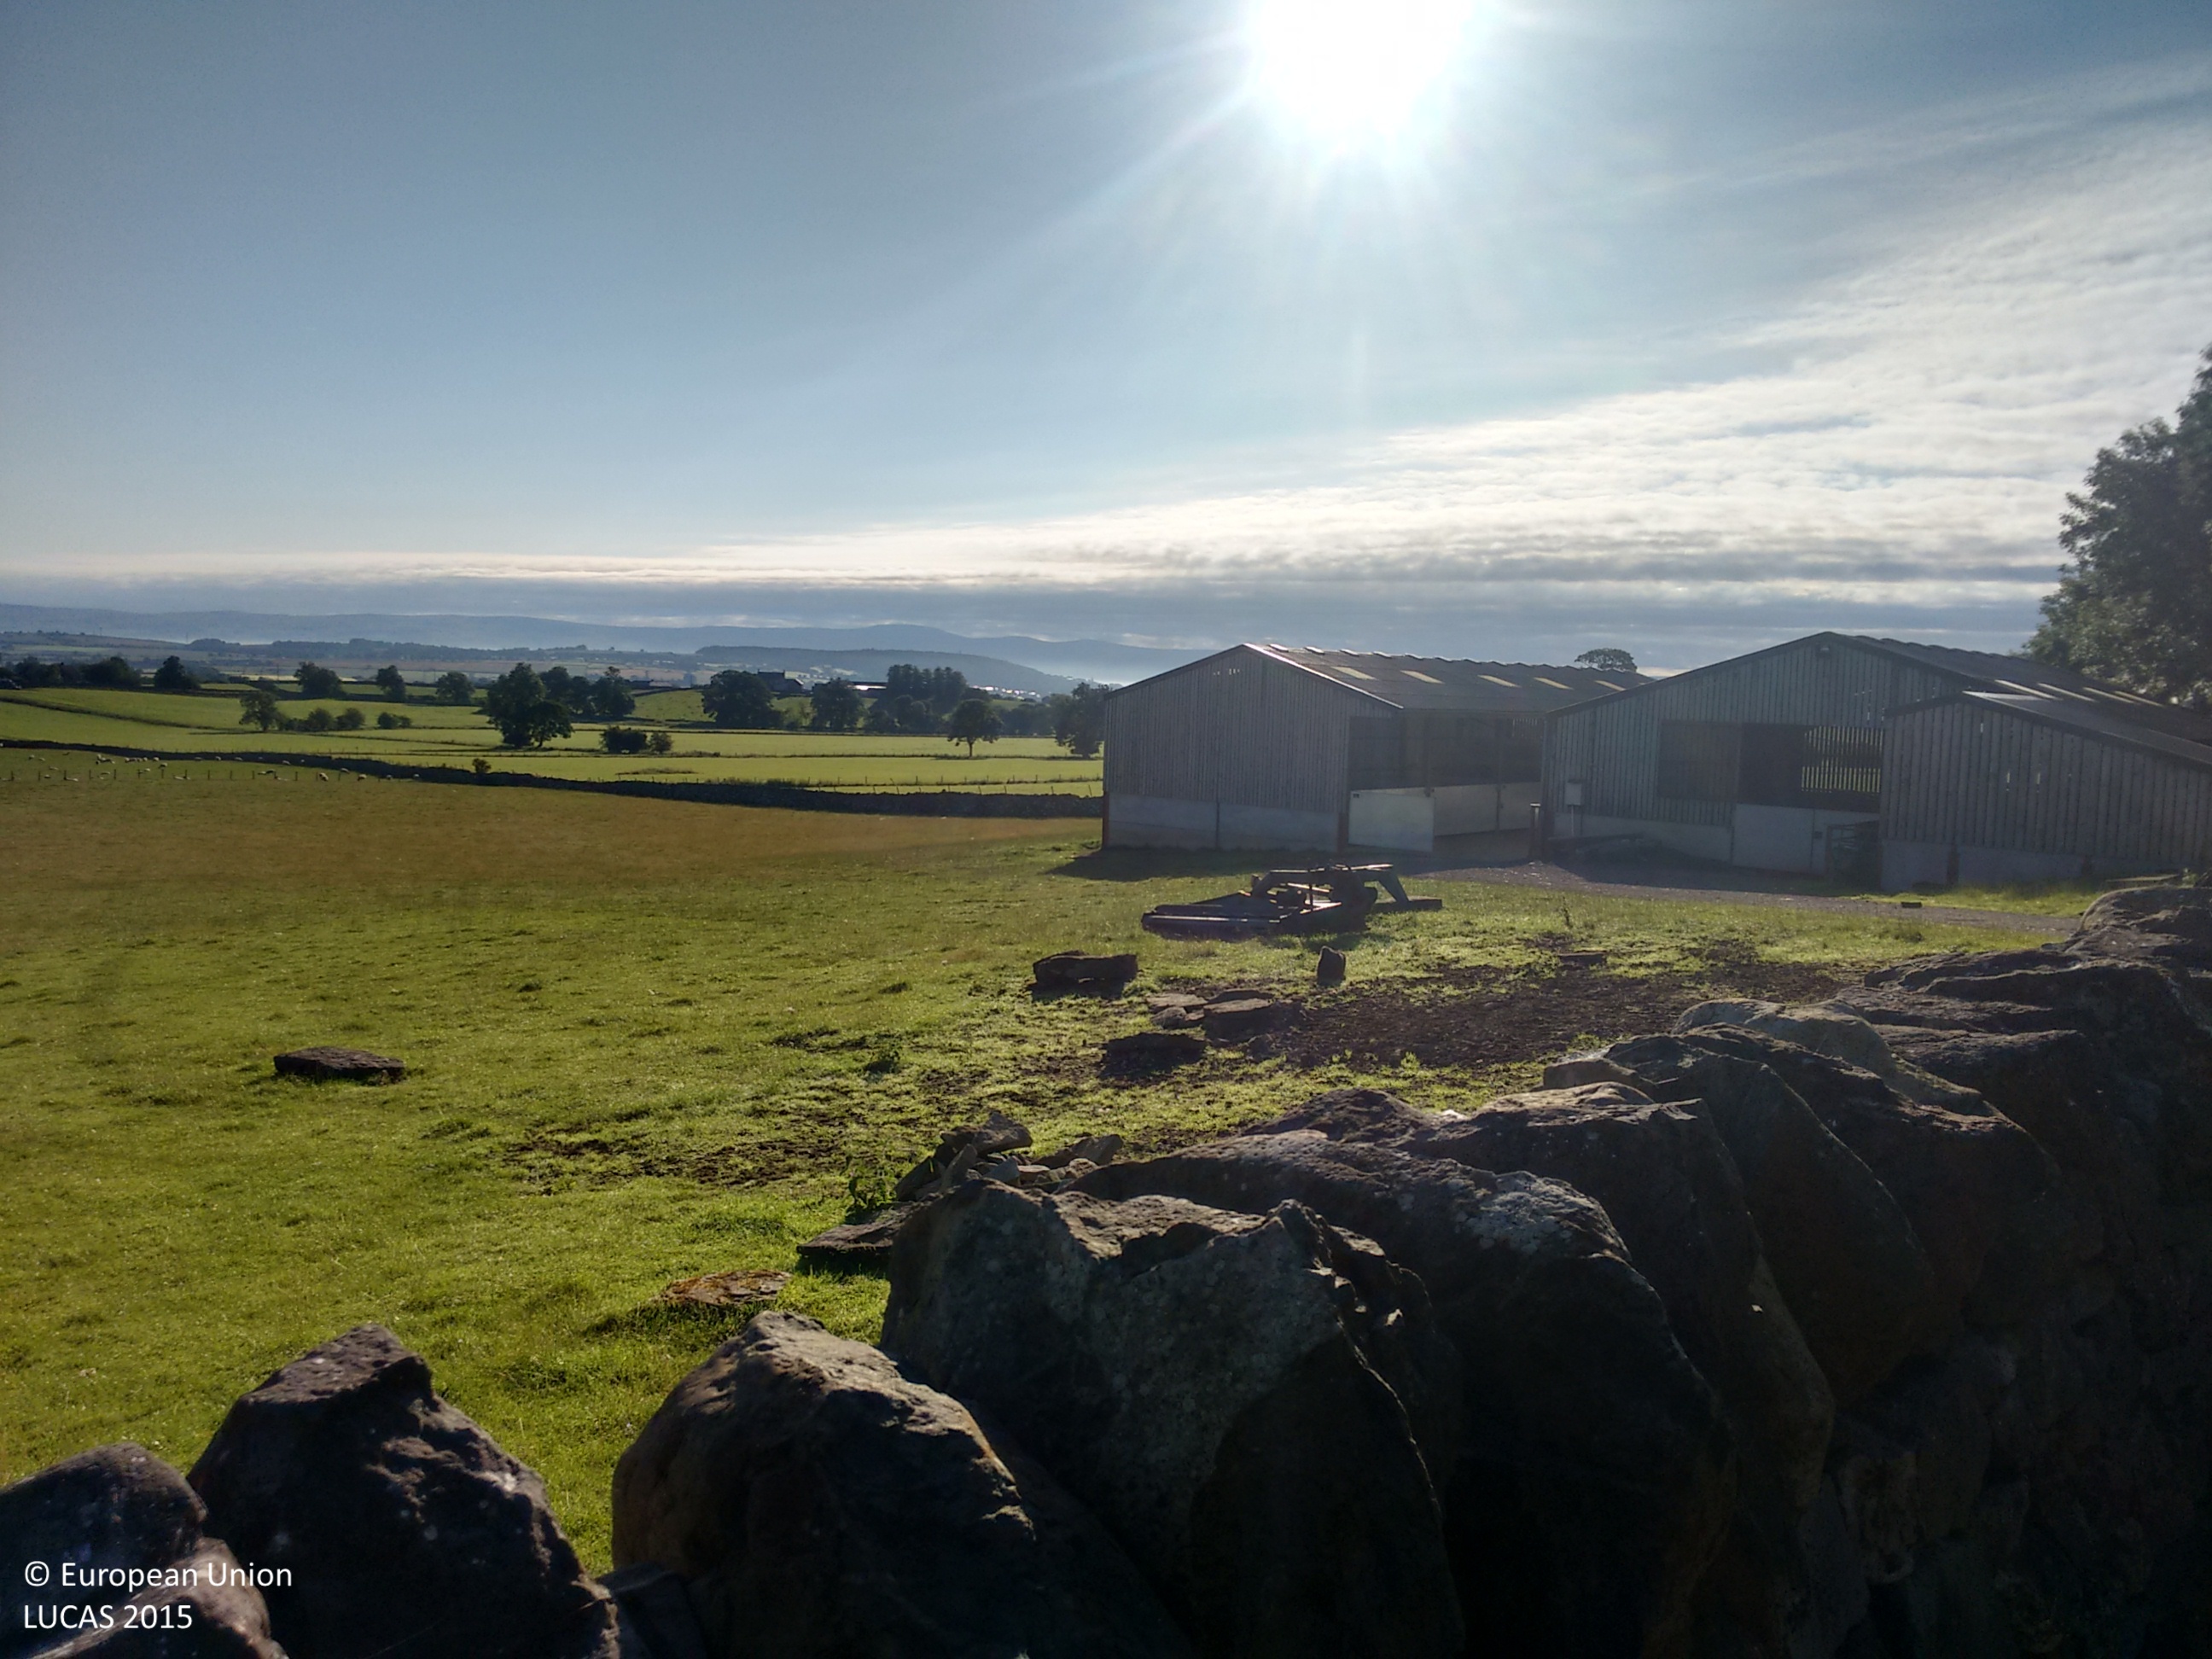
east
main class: Grassland
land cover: Grassland without tree/shrub cover
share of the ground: > 75 %
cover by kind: herbaceous plants 100 %
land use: Agriculture (excluding fallow land and kitchen gardens)
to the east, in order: Grassland without tree/shrub cover; Dry stone walls; Grassland without tree/shrub cover; Managed hedges; Grassland without tree/shrub cover
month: August
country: GB
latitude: 54.6654
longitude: -2.8289
